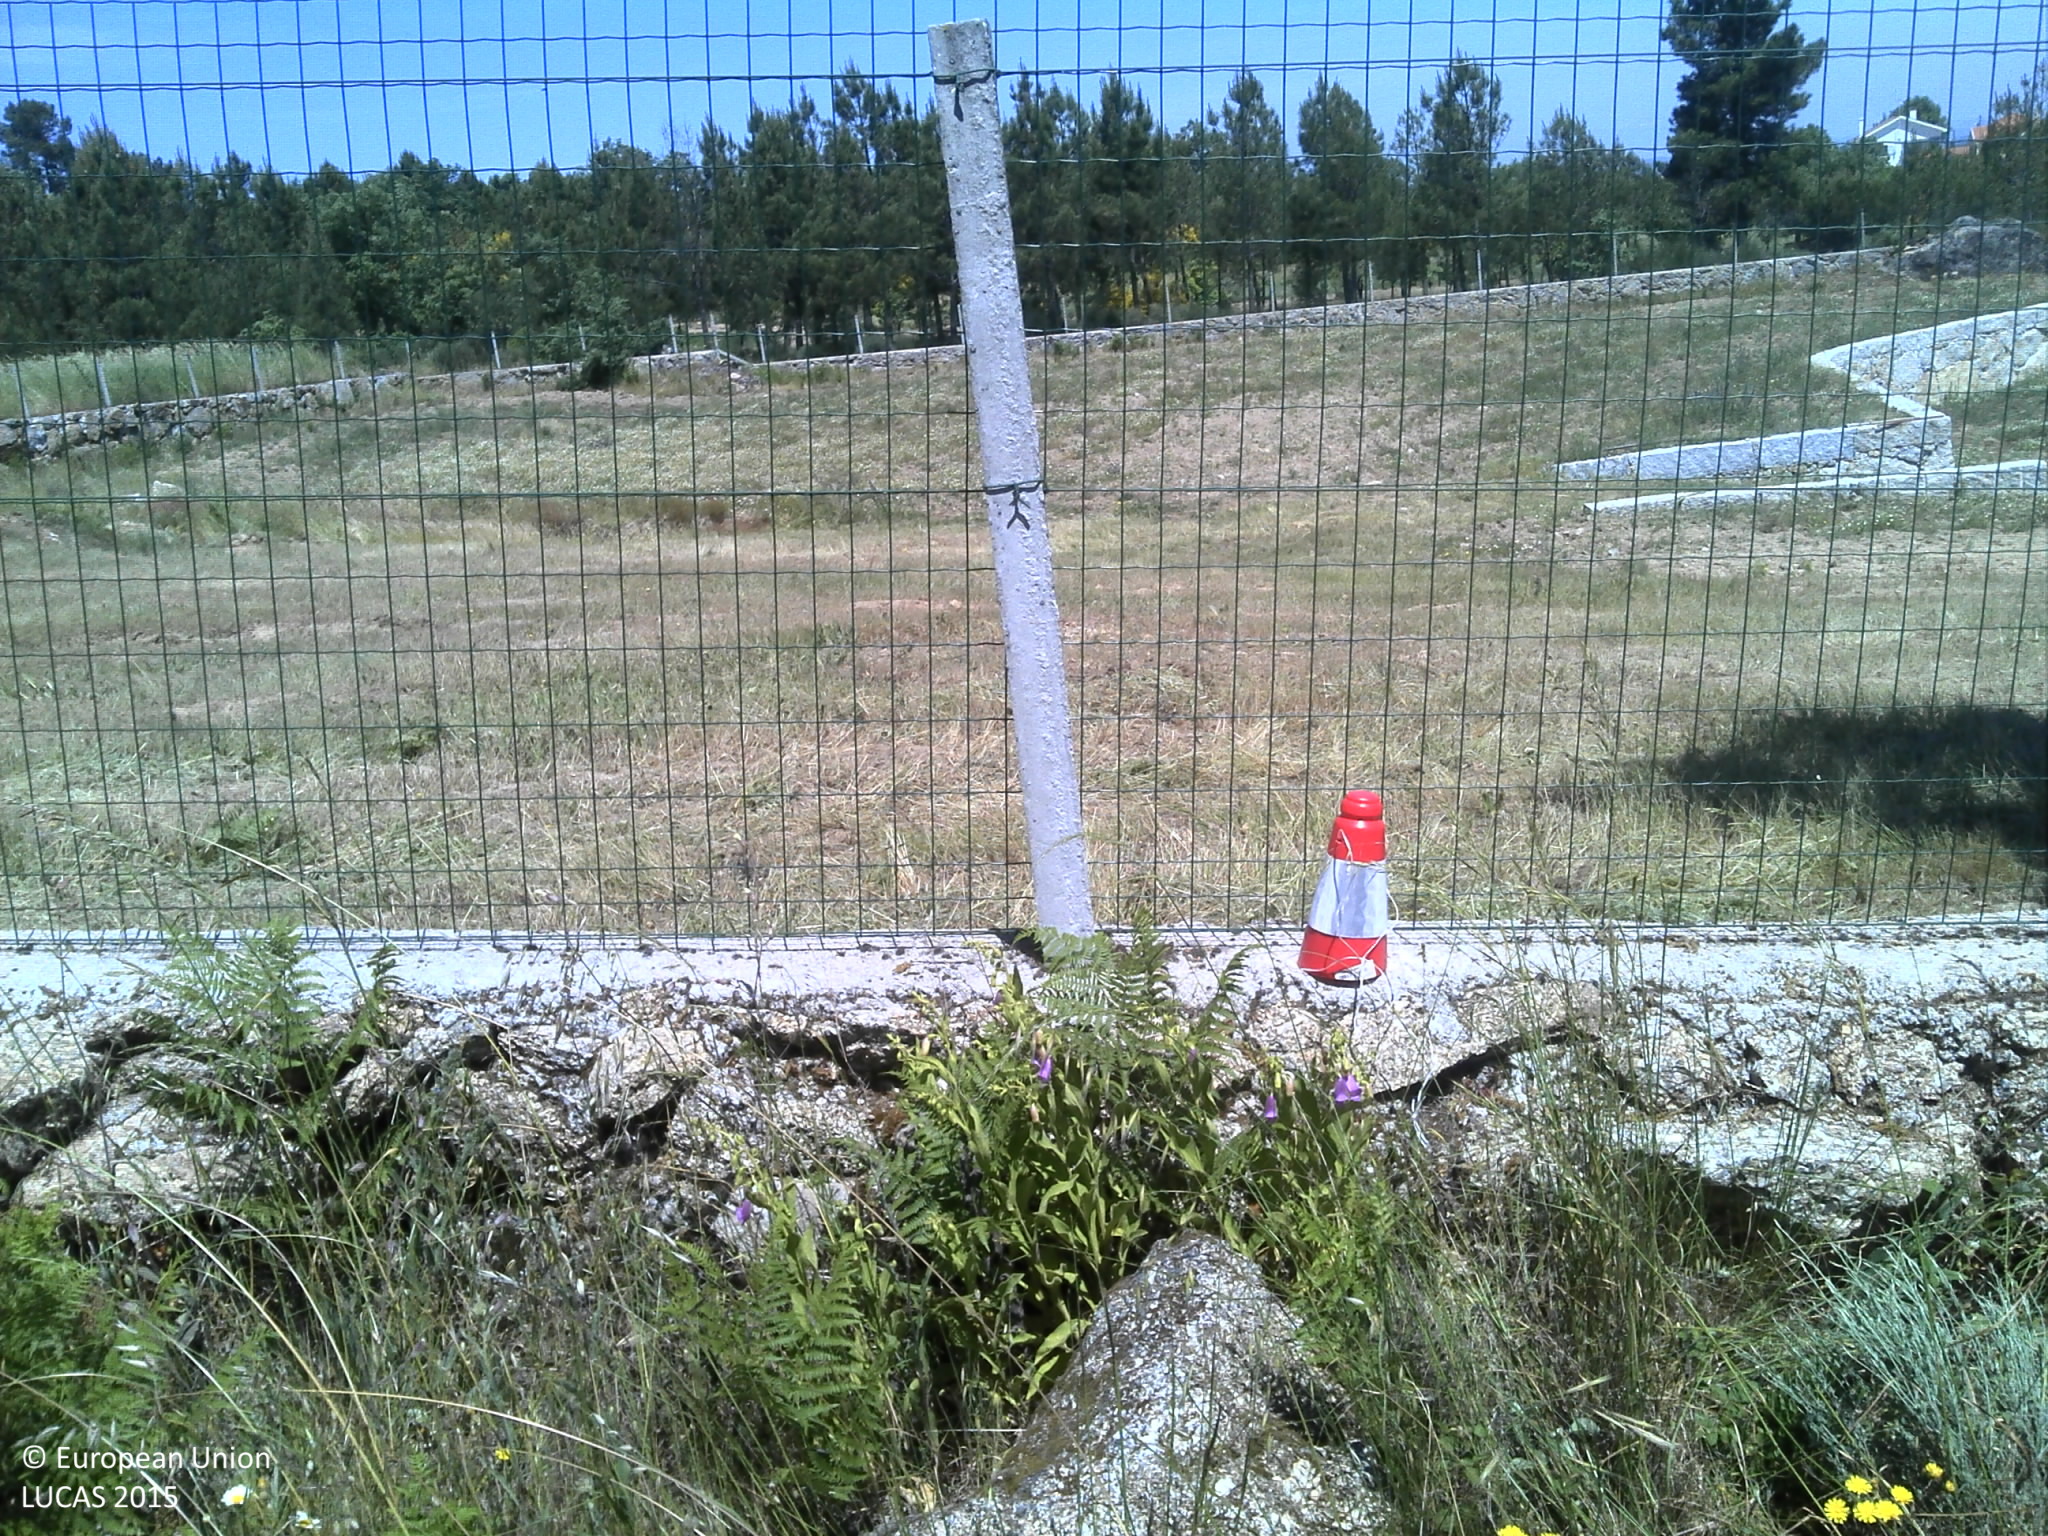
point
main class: Grassland
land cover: Grassland without tree/shrub cover
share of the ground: 25 - 50 %
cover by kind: herbaceous plants 50 %, consolidated bare surface 40 %
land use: Agriculture (excluding fallow land and kitchen gardens)
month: May
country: PT
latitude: 40.6461
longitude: -7.2421
